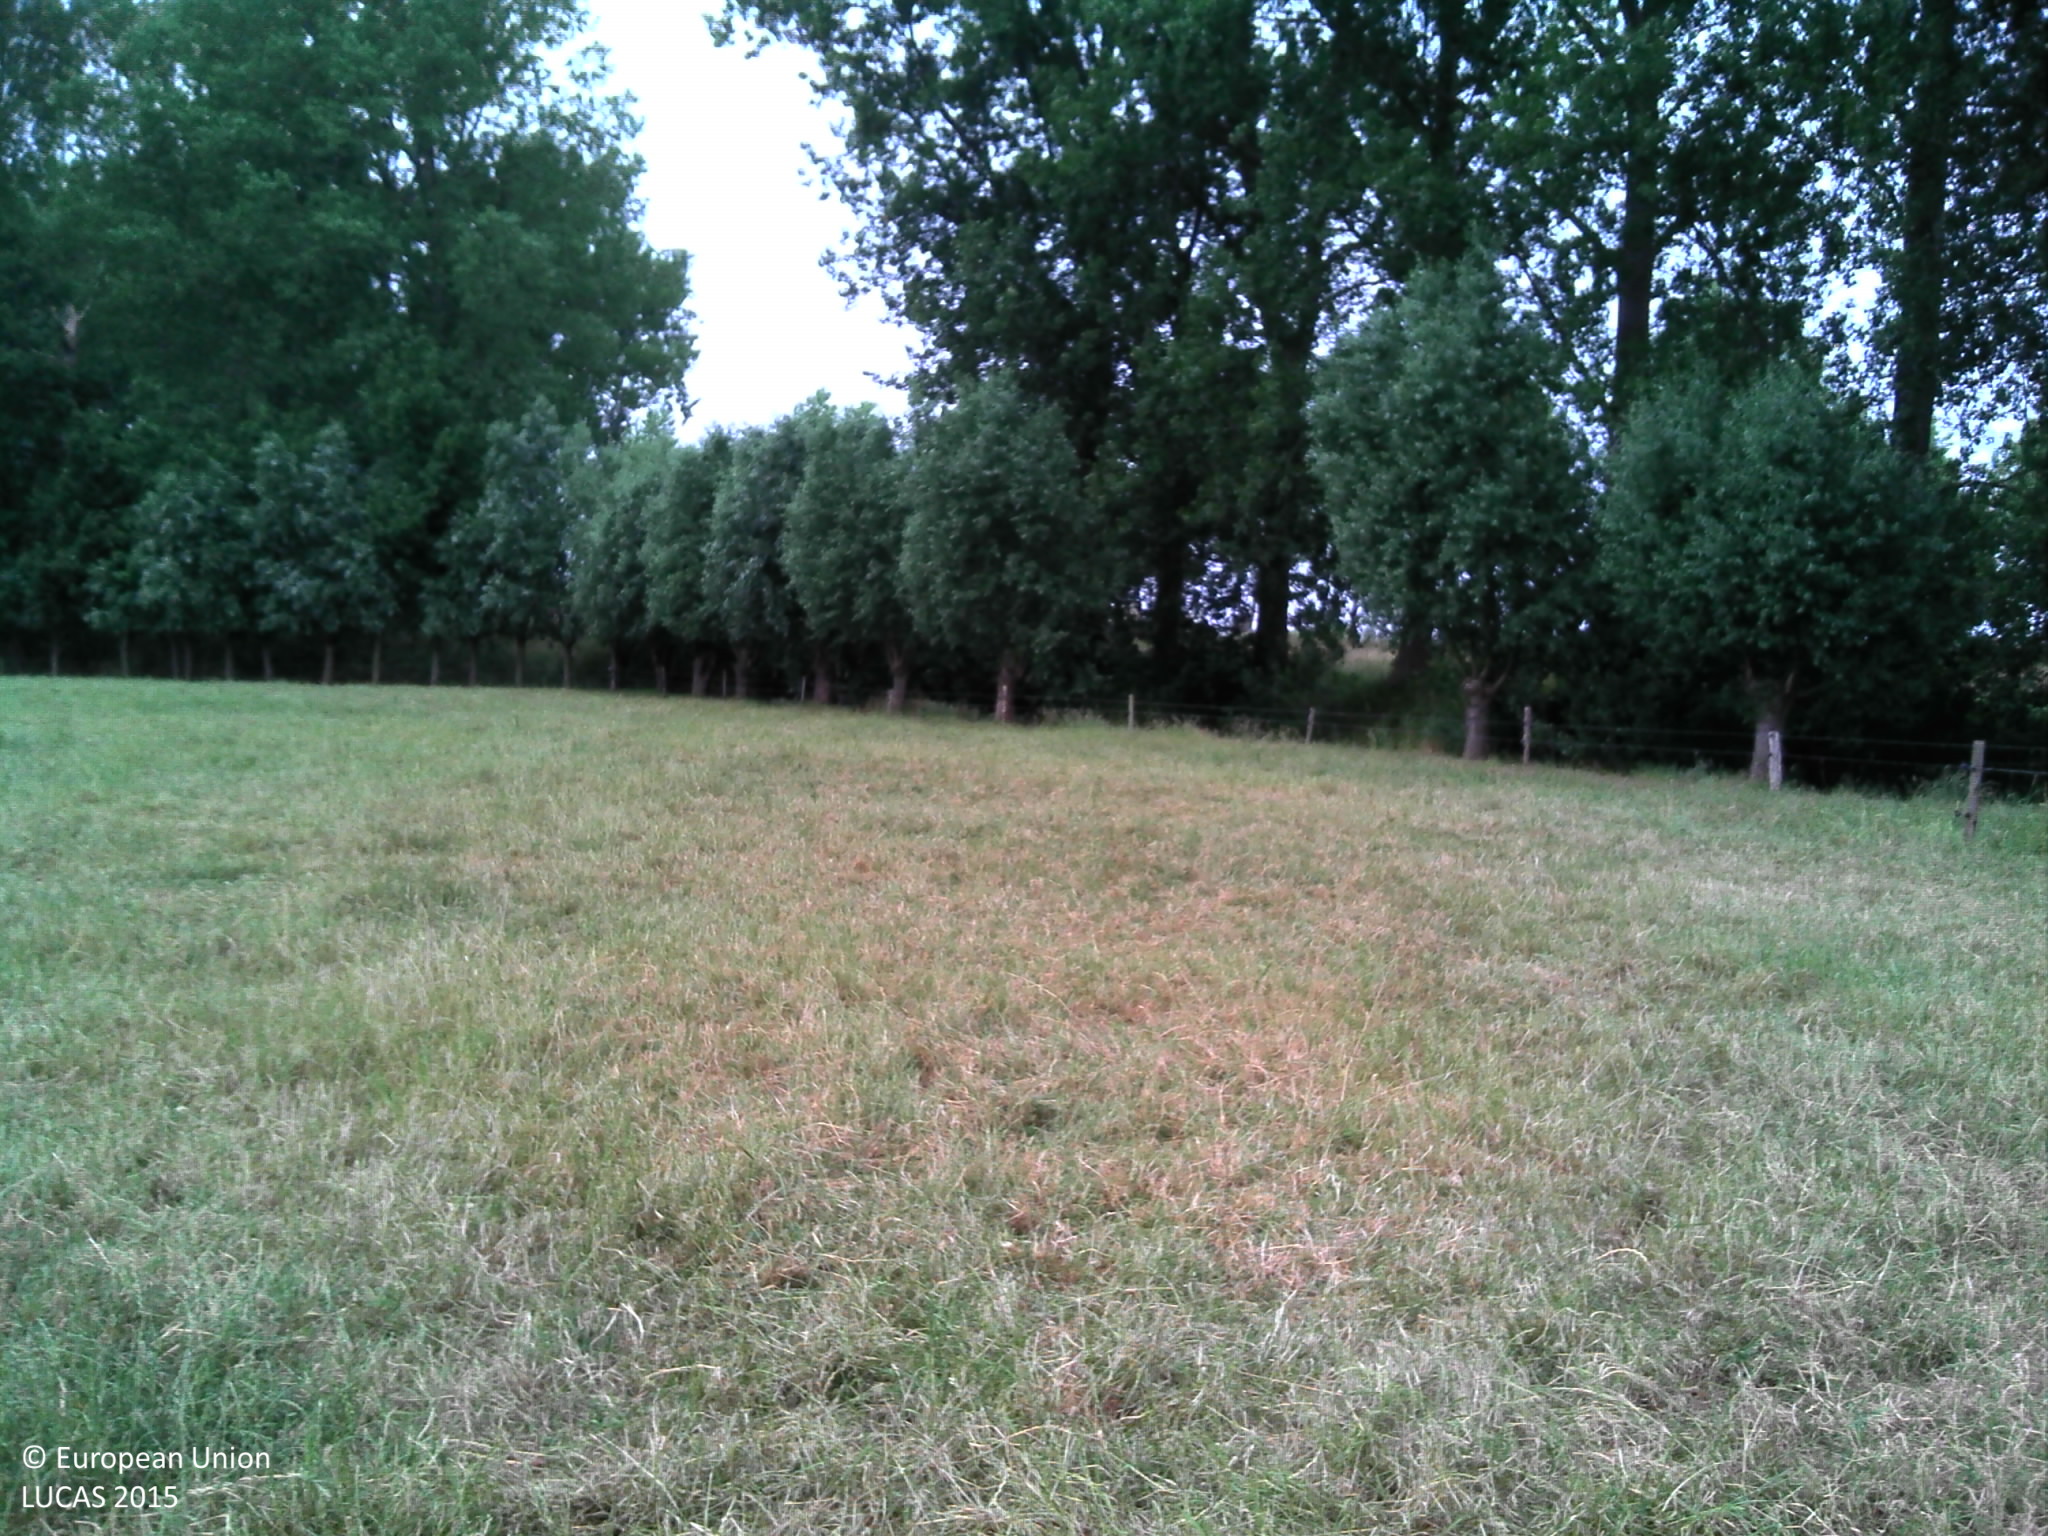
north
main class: Grassland
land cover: Grassland without tree/shrub cover
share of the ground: > 75 %
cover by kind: herbaceous plants 100 %
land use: Agriculture (excluding fallow land and kitchen gardens)
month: July
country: BE
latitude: 51.2452
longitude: 3.5315
